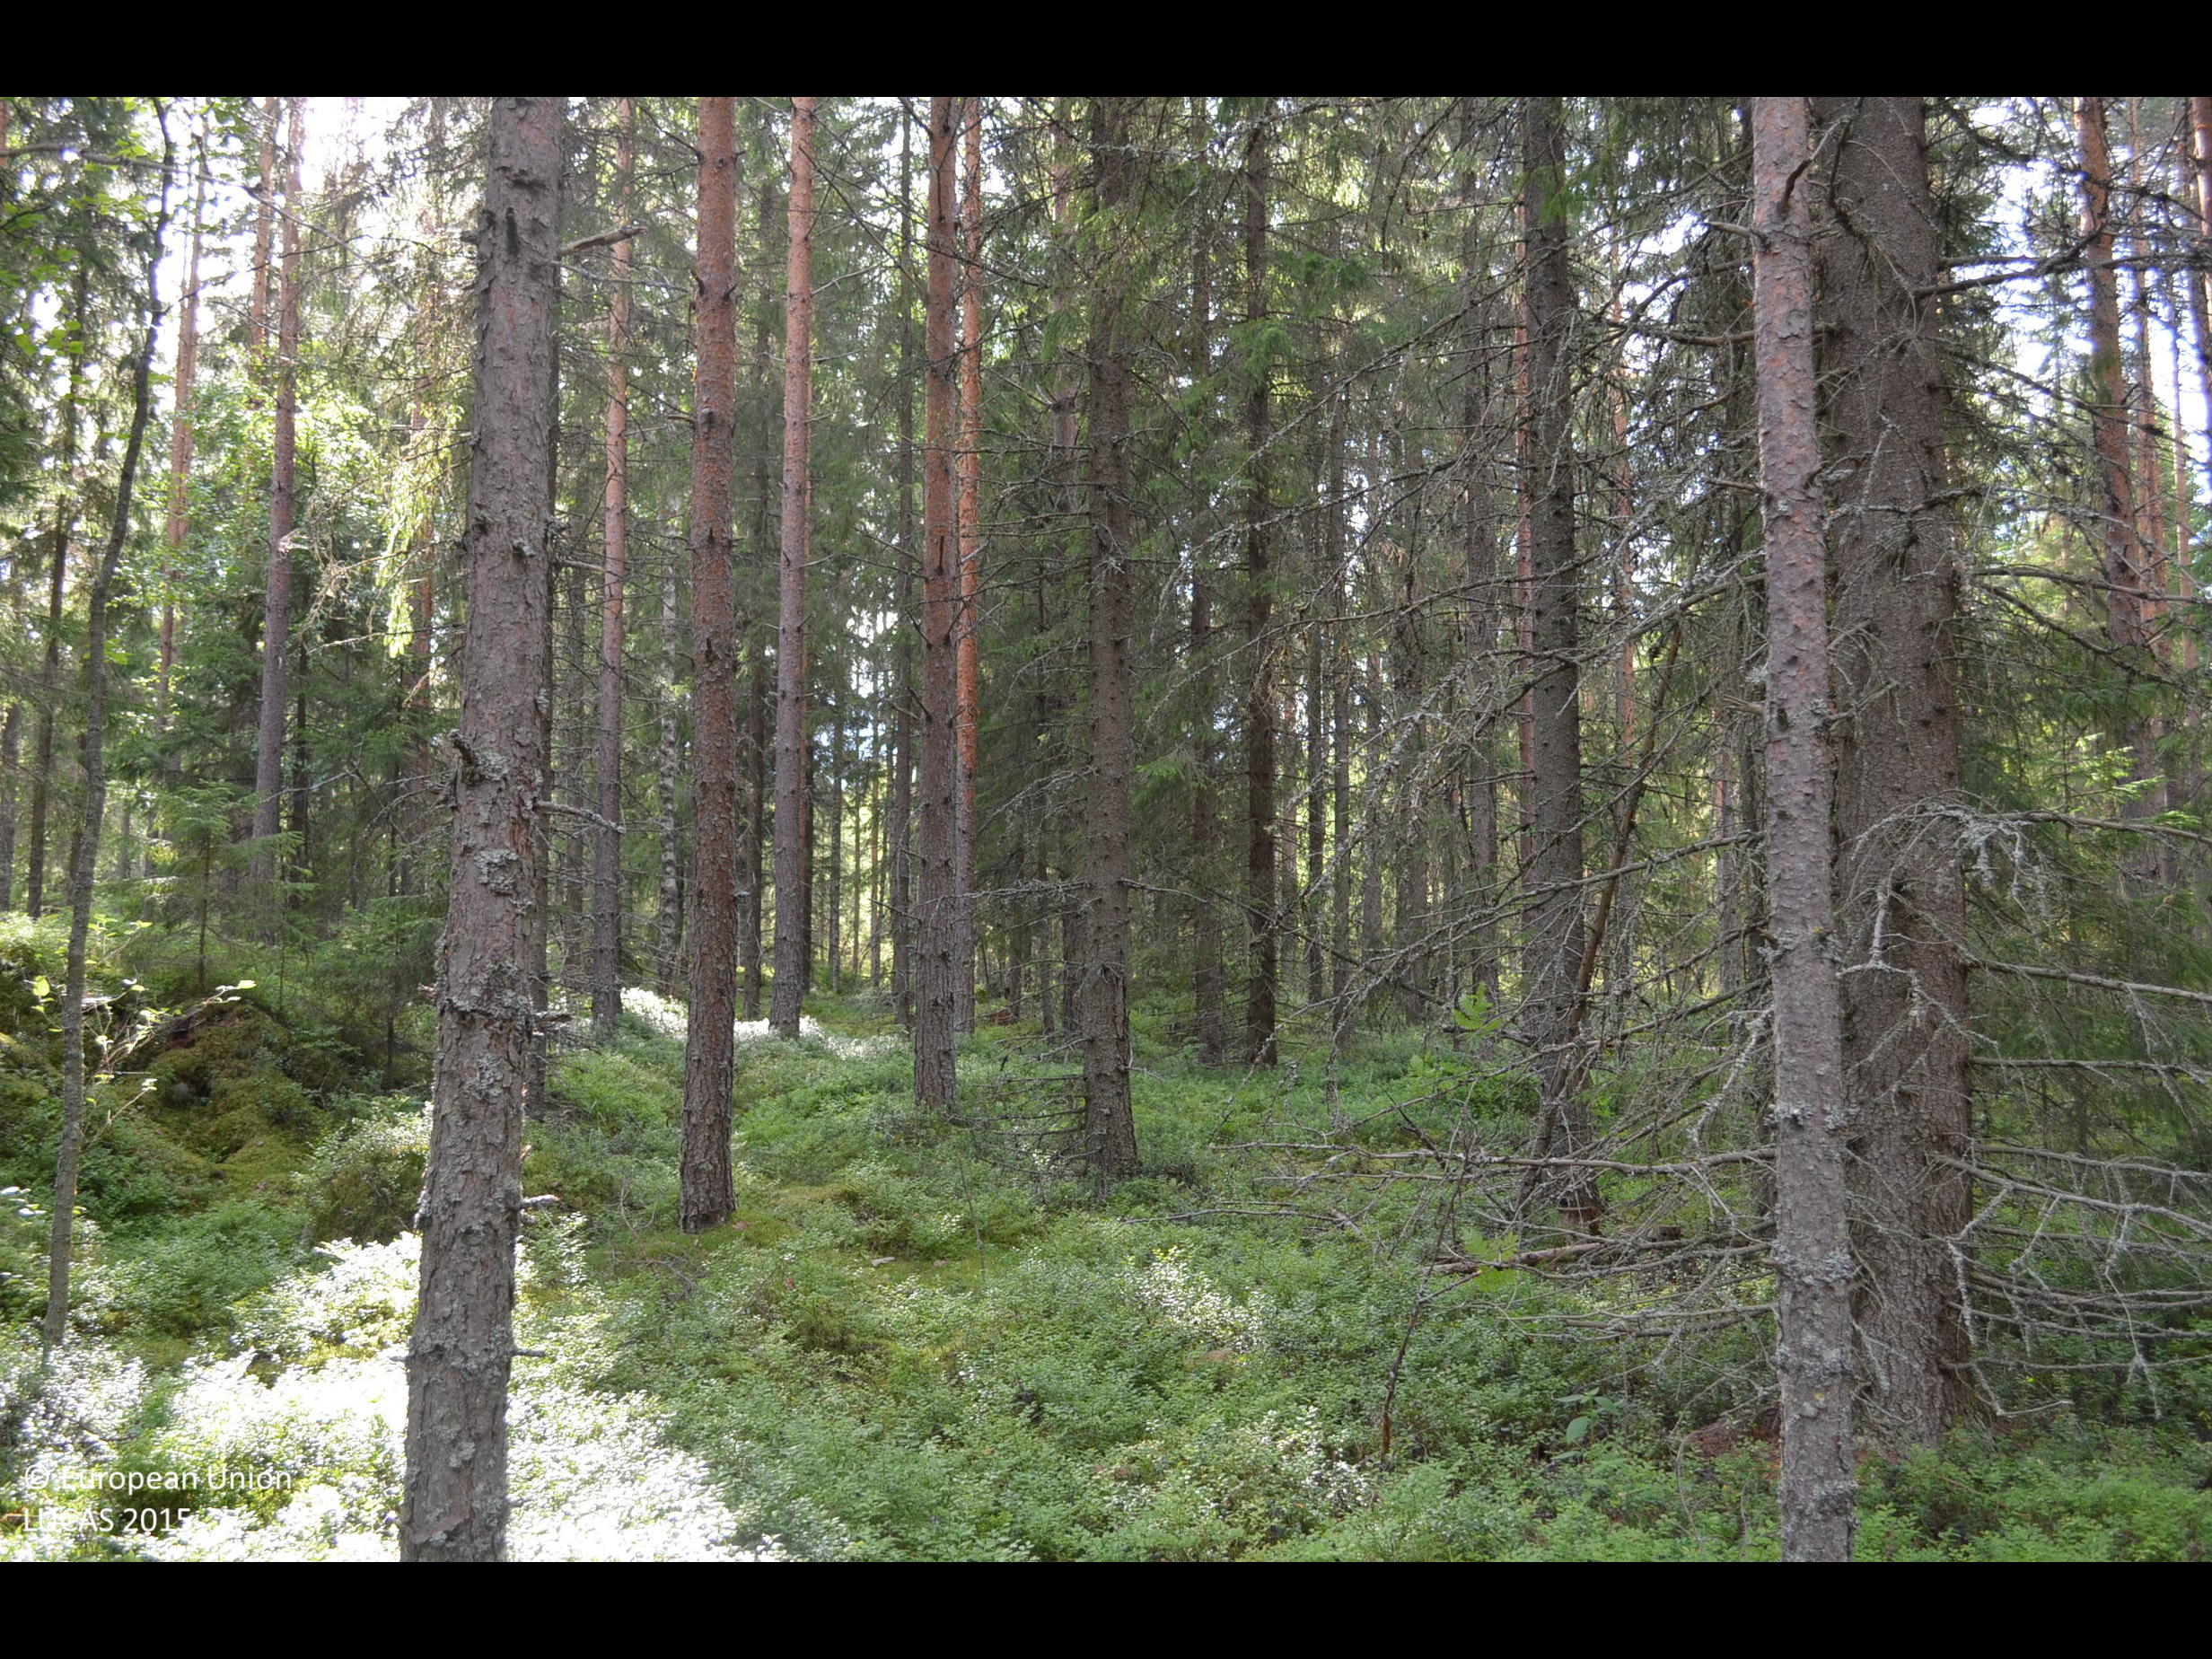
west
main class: Woodland
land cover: Other coniferous woodland
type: boreal forest
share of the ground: > 75 %
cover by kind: coniferous forest trees 70 %, shrubs 25 %, broadleaved forest trees 5 %
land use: Forestry
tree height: > 5 m
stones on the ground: < 10 %
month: July
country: FI
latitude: 61.9970
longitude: 24.3140
